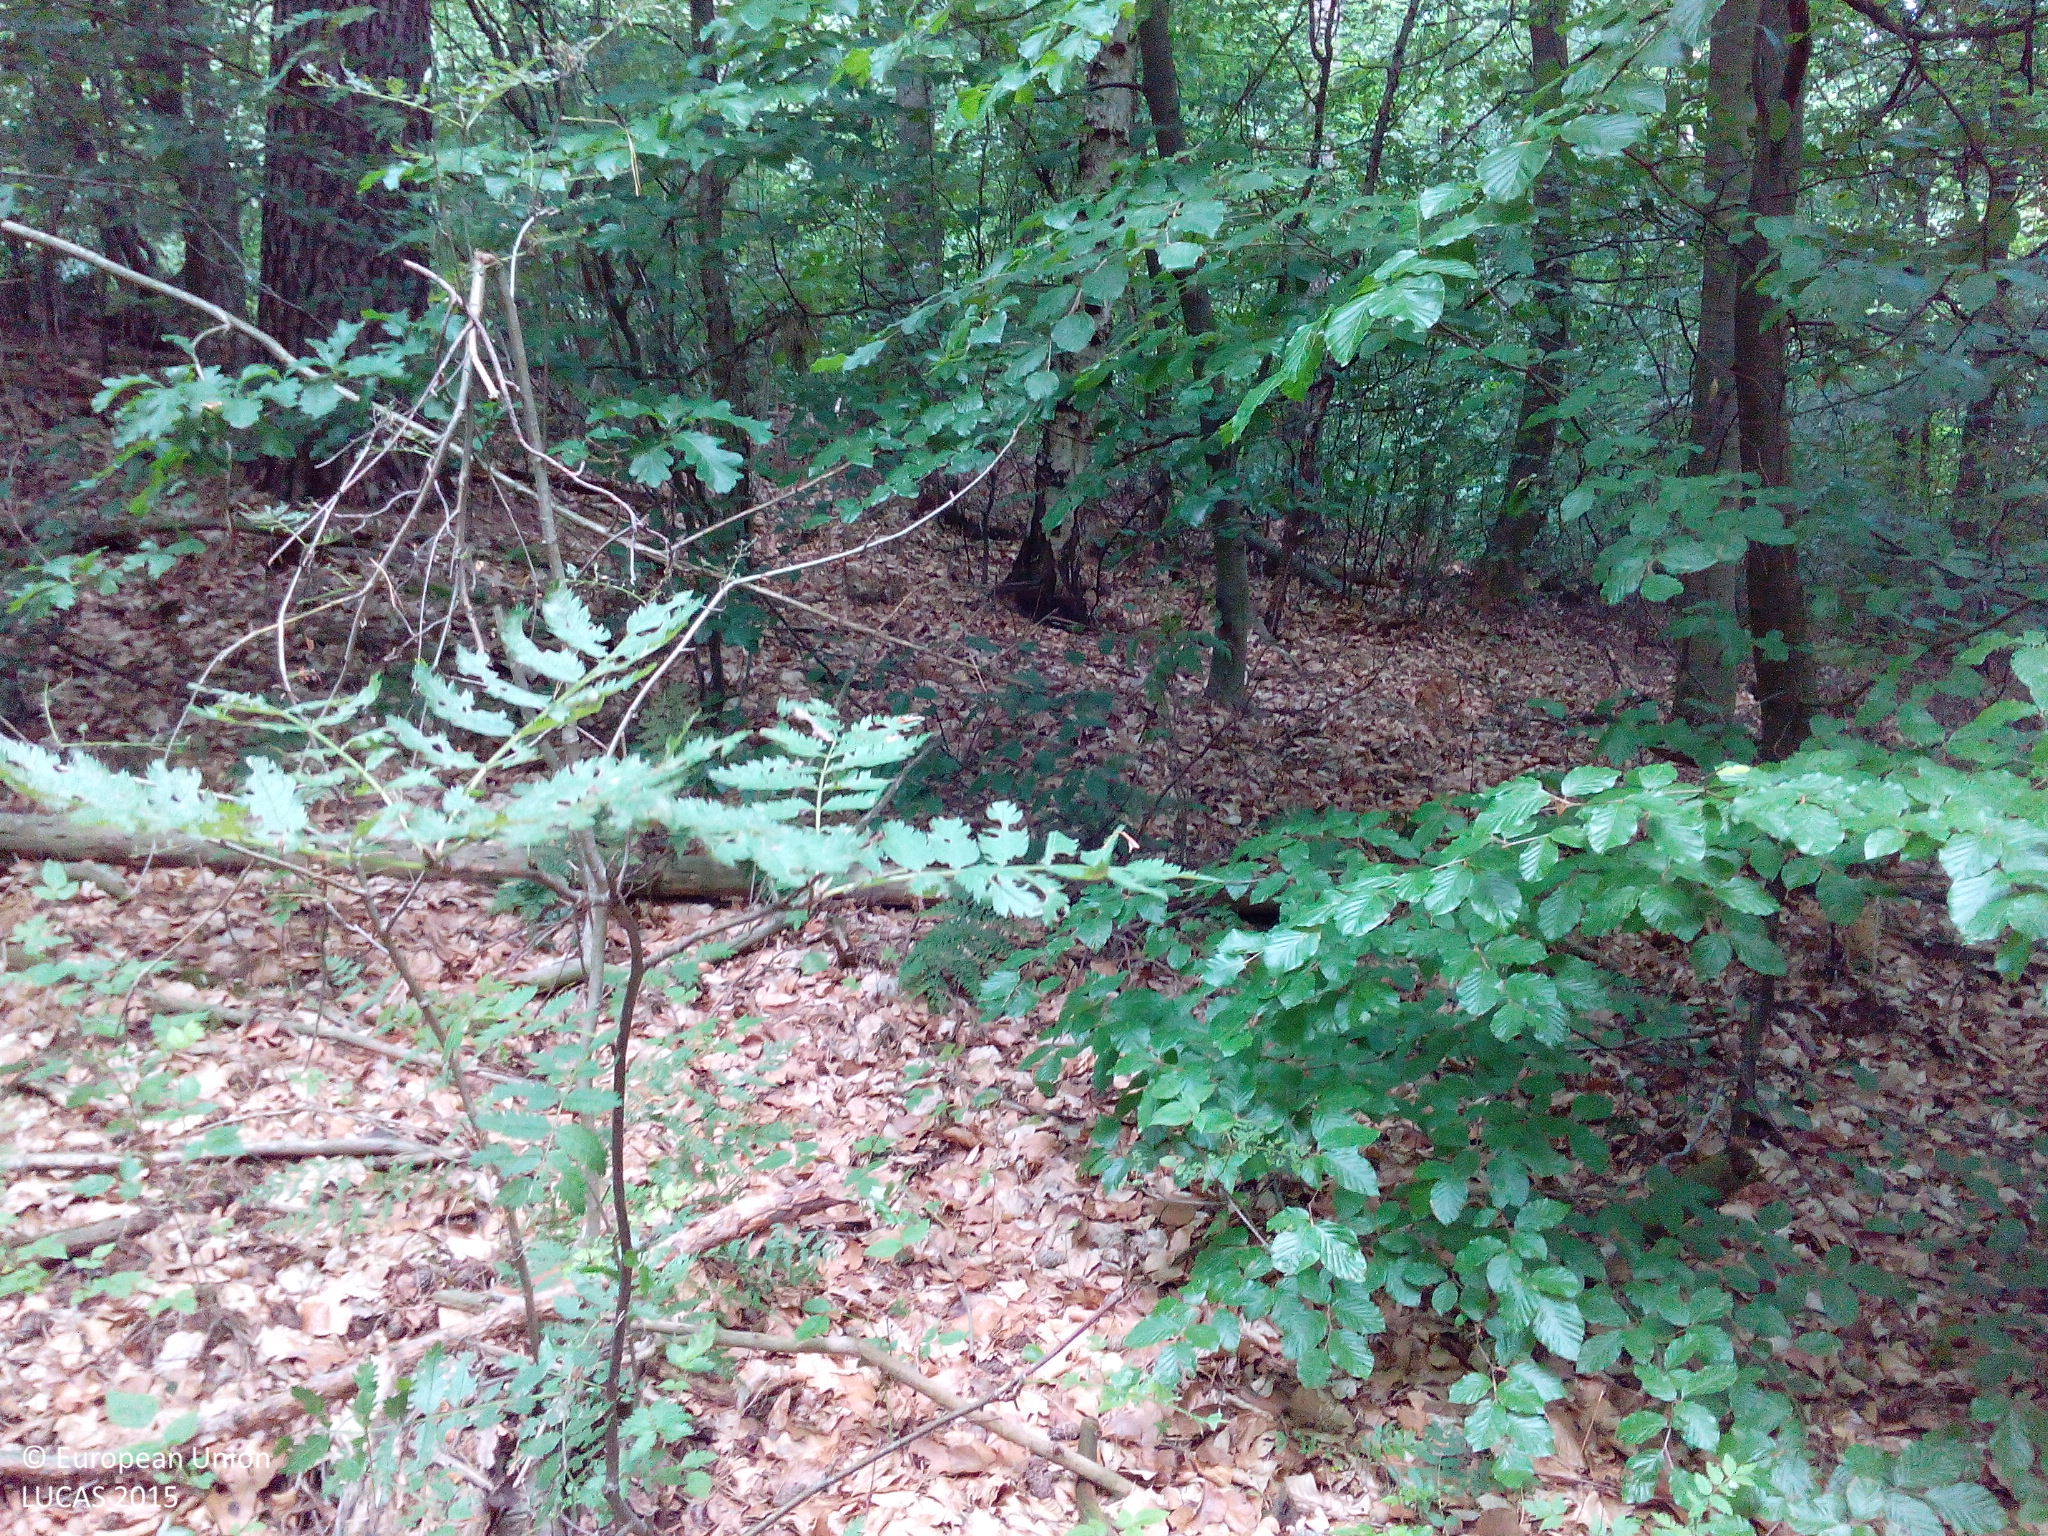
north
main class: Woodland
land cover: Pine dominated mixed woodland
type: hemiboreal forest and nemoral coniferous forest and mixed broadleaved-coniferous forest
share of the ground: > 75 %
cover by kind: coniferous forest trees 50 %, broadleaved forest trees 45 %, shrubs 5 %
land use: Forestry
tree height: > 5 m
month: July
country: DE
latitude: 52.7547
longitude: 13.6007
